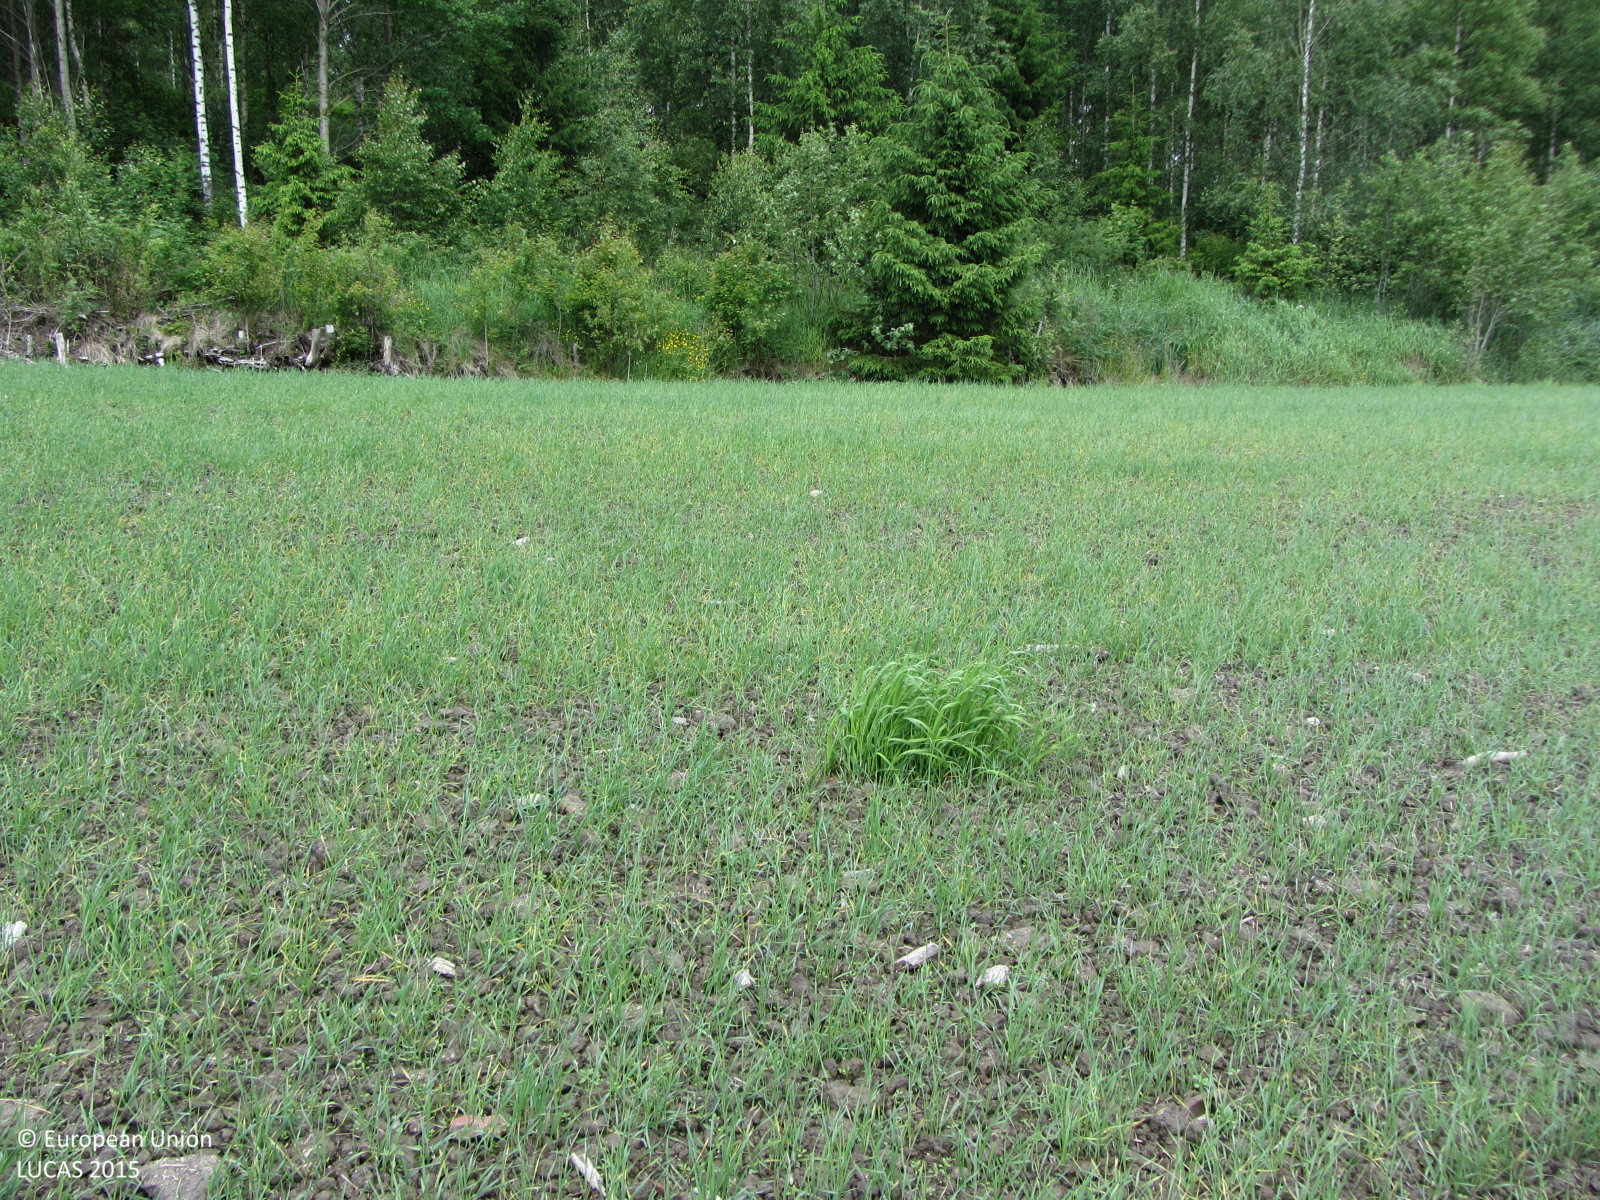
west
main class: Cropland
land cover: Common wheat
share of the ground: > 75 %
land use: Agriculture (excluding fallow land and kitchen gardens)
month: June
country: FI
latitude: 60.2501
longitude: 23.2179
